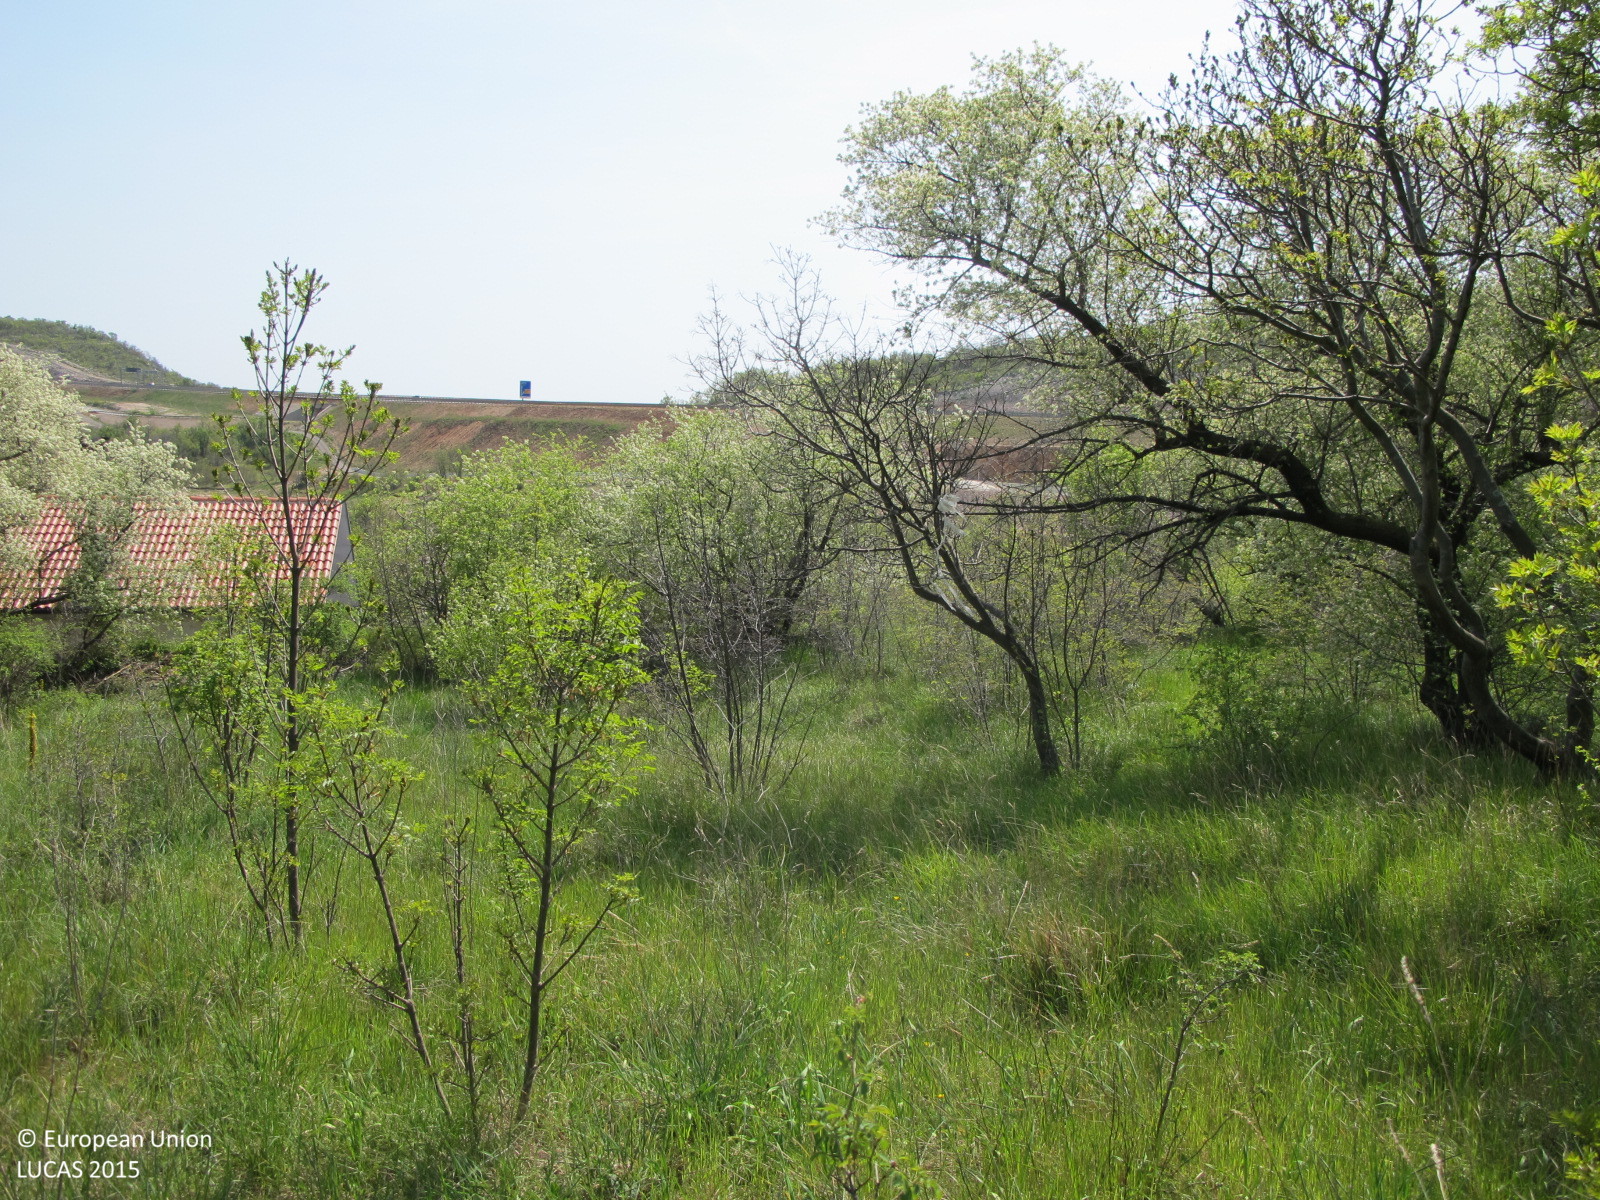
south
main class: Grassland
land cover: Grassland with sparse tree/shrub cover
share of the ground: > 75 %
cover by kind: herbaceous plants 70 %, shrubs 10 %, broadleaved forest trees 5 %
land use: Abandoned areas
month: April
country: HR
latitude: 45.2971
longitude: 14.5729
